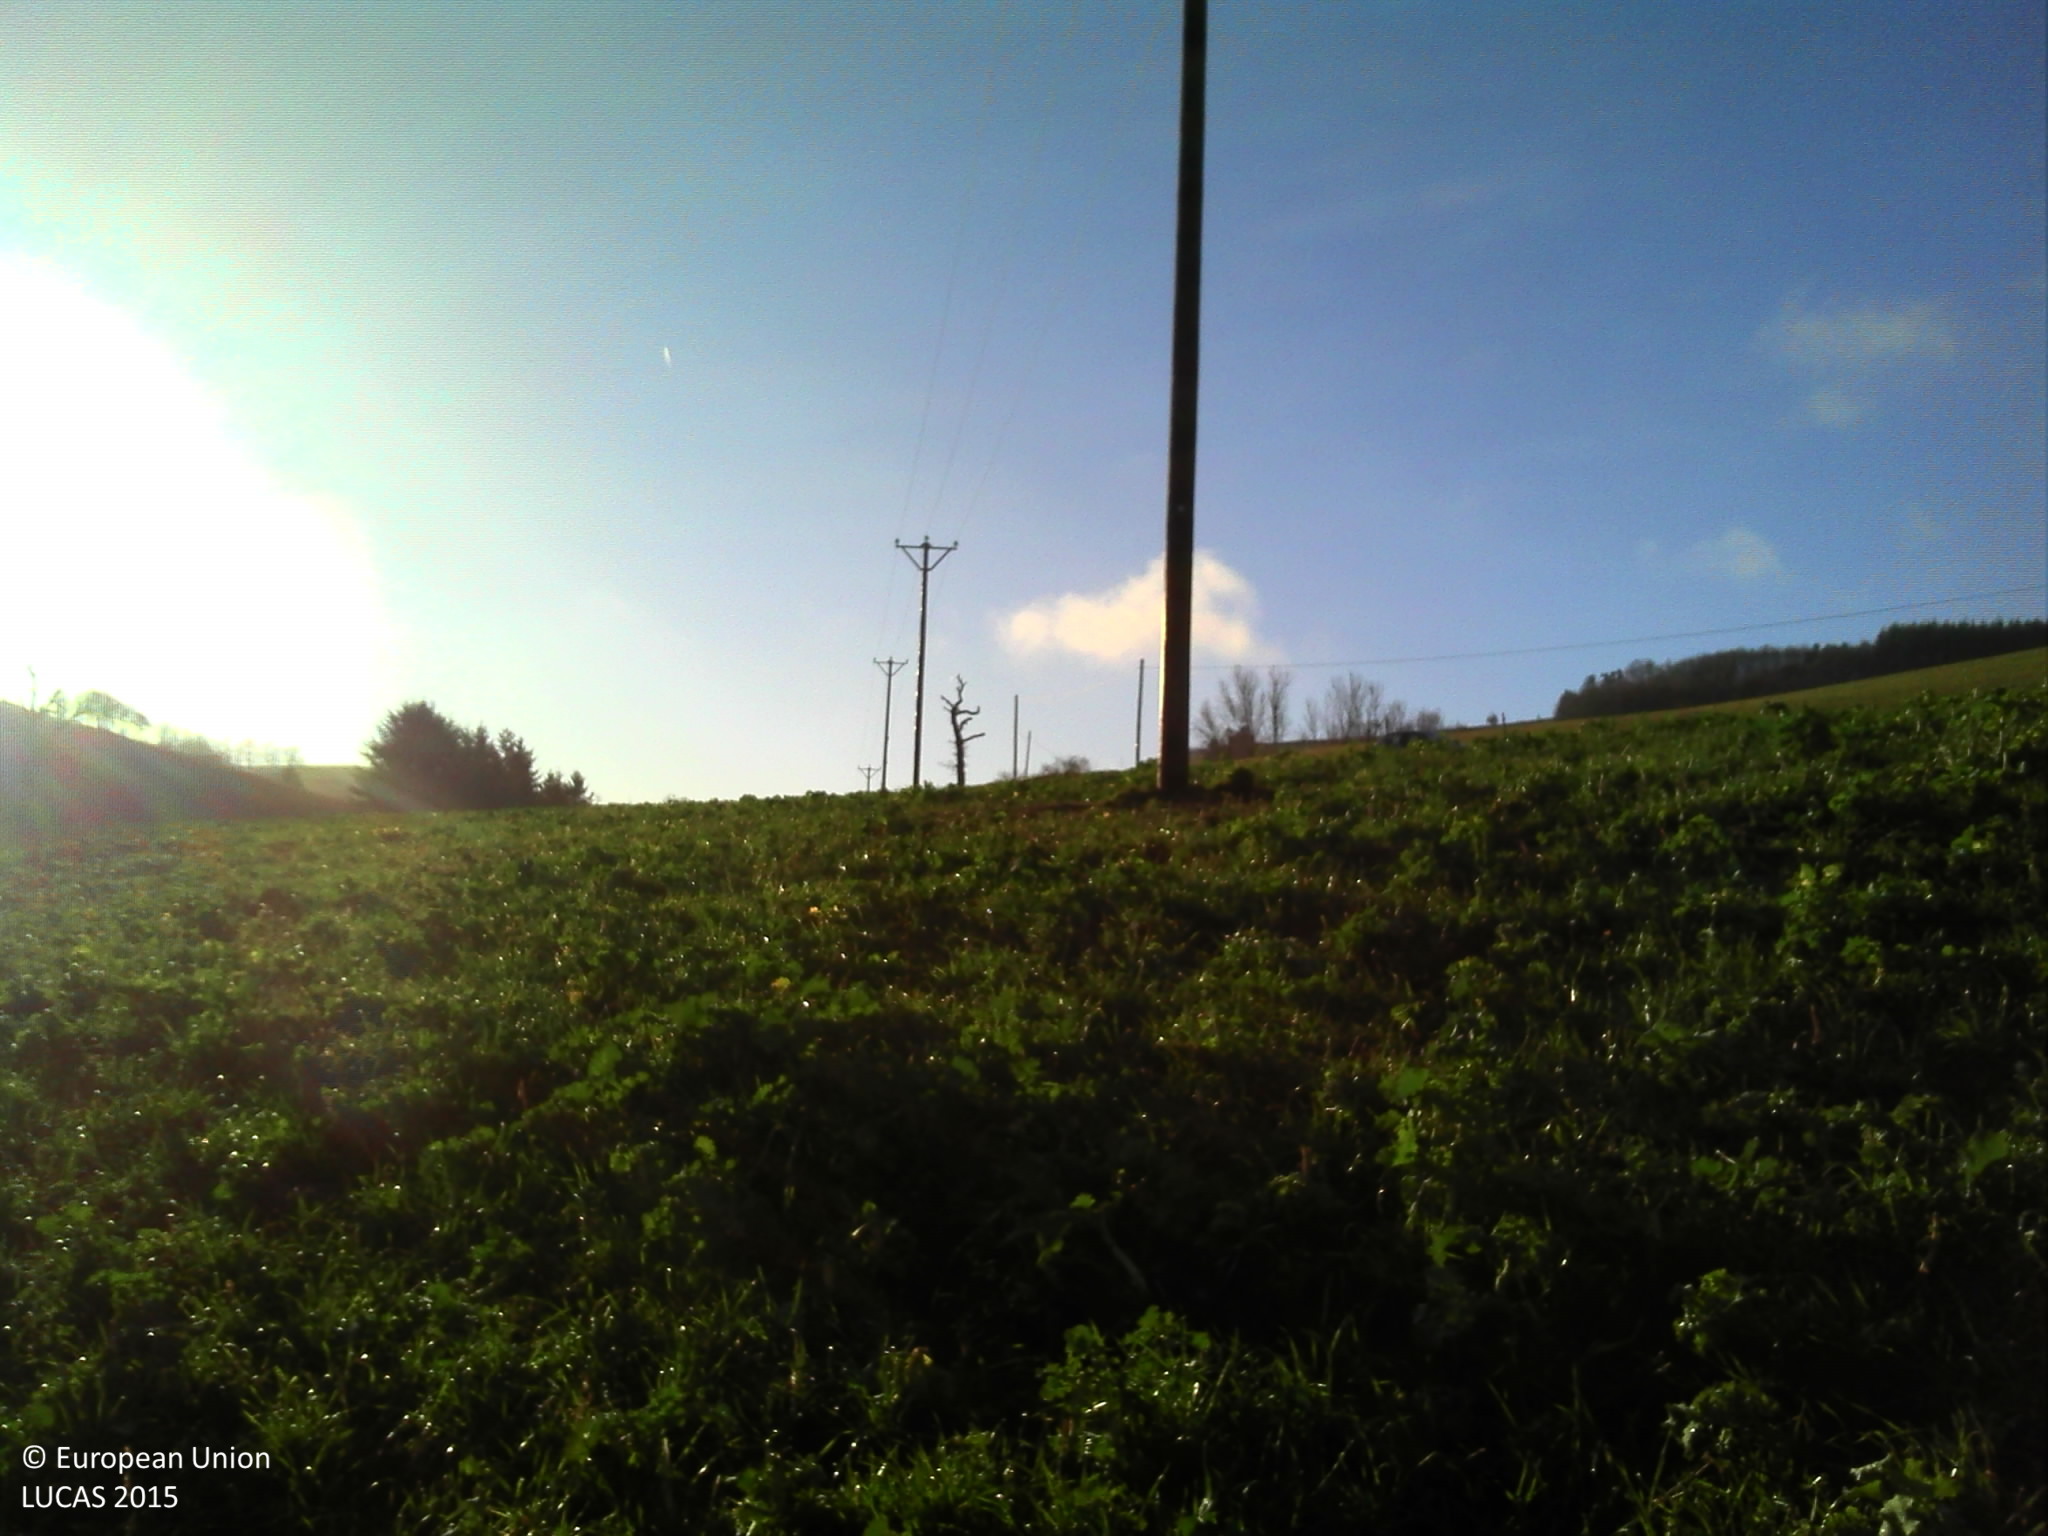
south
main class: Cropland
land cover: Rape and turnip rape
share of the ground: > 75 %
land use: Agriculture (excluding fallow land and kitchen gardens)
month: December
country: FR
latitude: 45.5588
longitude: 4.4821
